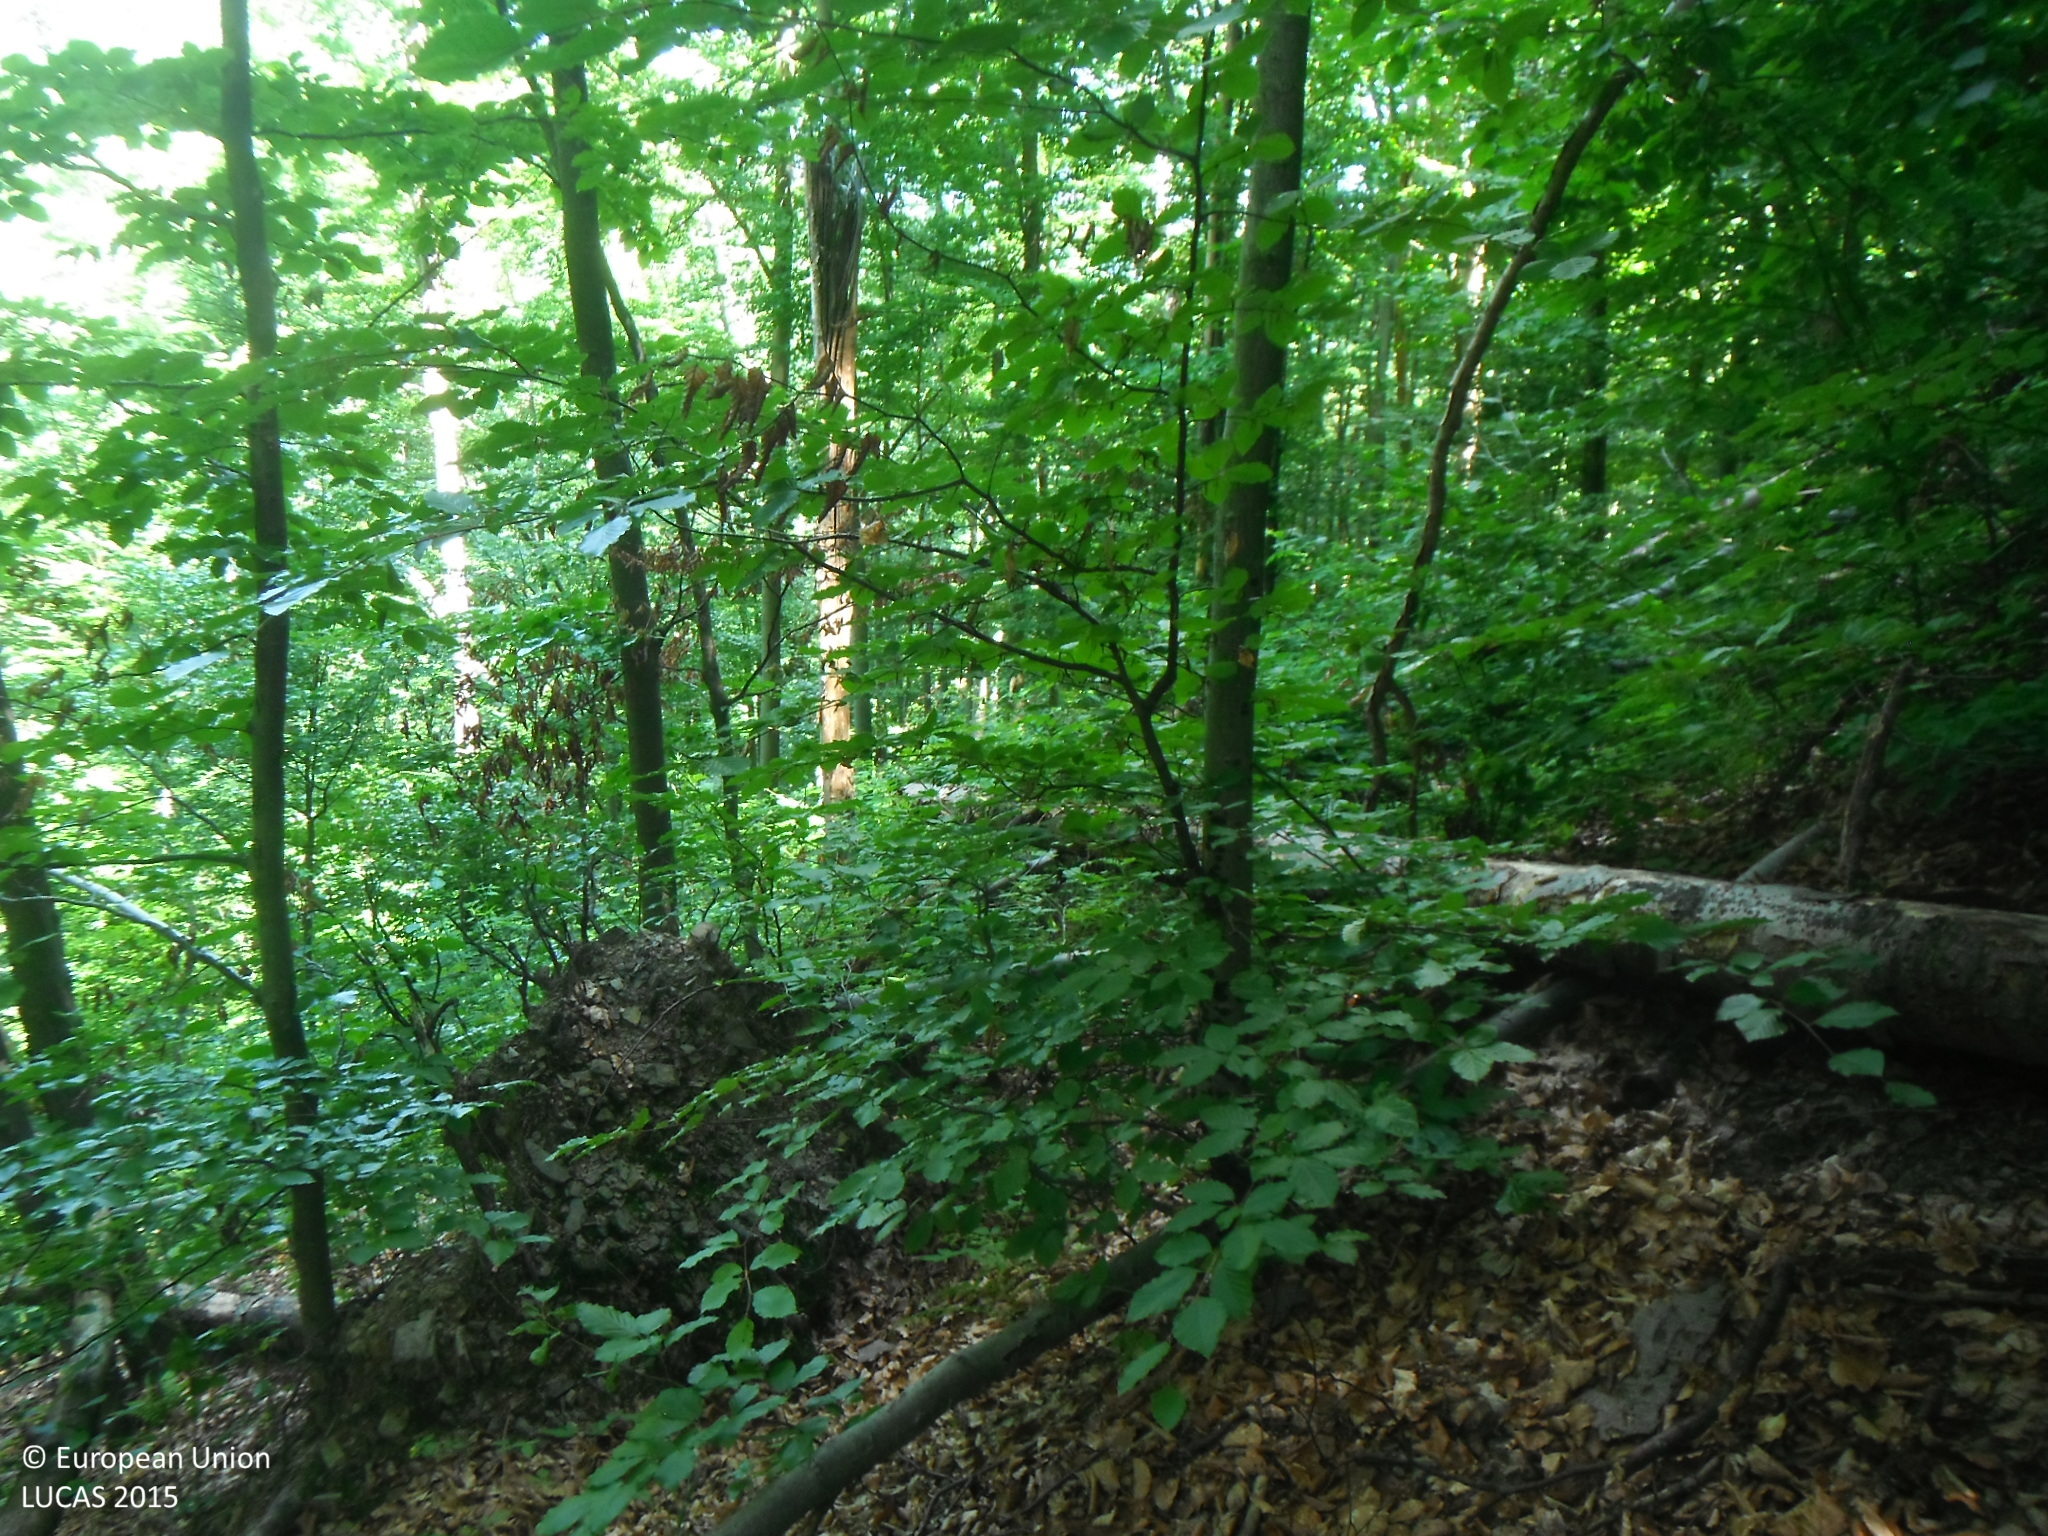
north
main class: Woodland
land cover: Broadleaved woodland
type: beech forest
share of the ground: > 75 %
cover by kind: broadleaved forest trees 100 %
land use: Forestry
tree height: > 5 m
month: July
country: SK
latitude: 48.9972
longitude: 22.3762
